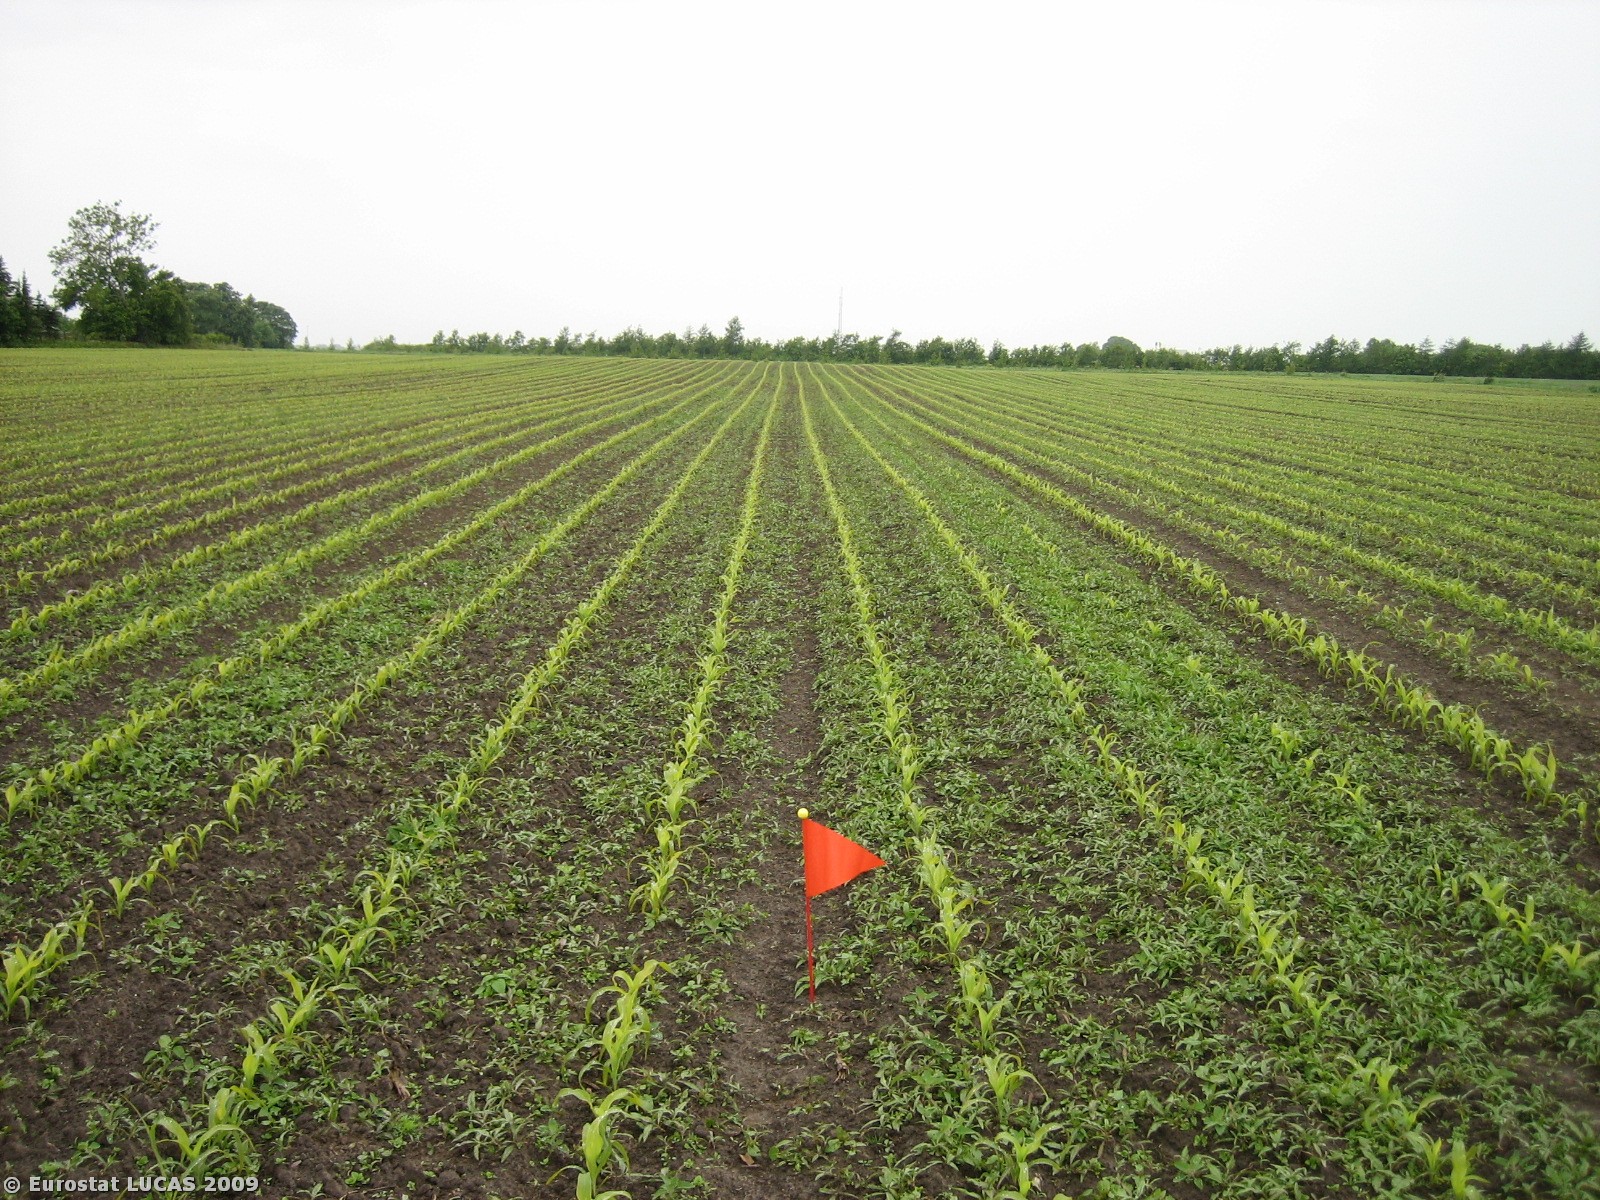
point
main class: Cropland
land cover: Maize
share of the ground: < 10 %
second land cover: Spontaneously vegetated surfaces
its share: 10 - 25 %
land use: Agriculture (excluding fallow land and kitchen gardens)
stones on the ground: < 10 %
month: June
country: DK
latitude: 56.2416
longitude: 10.1128
